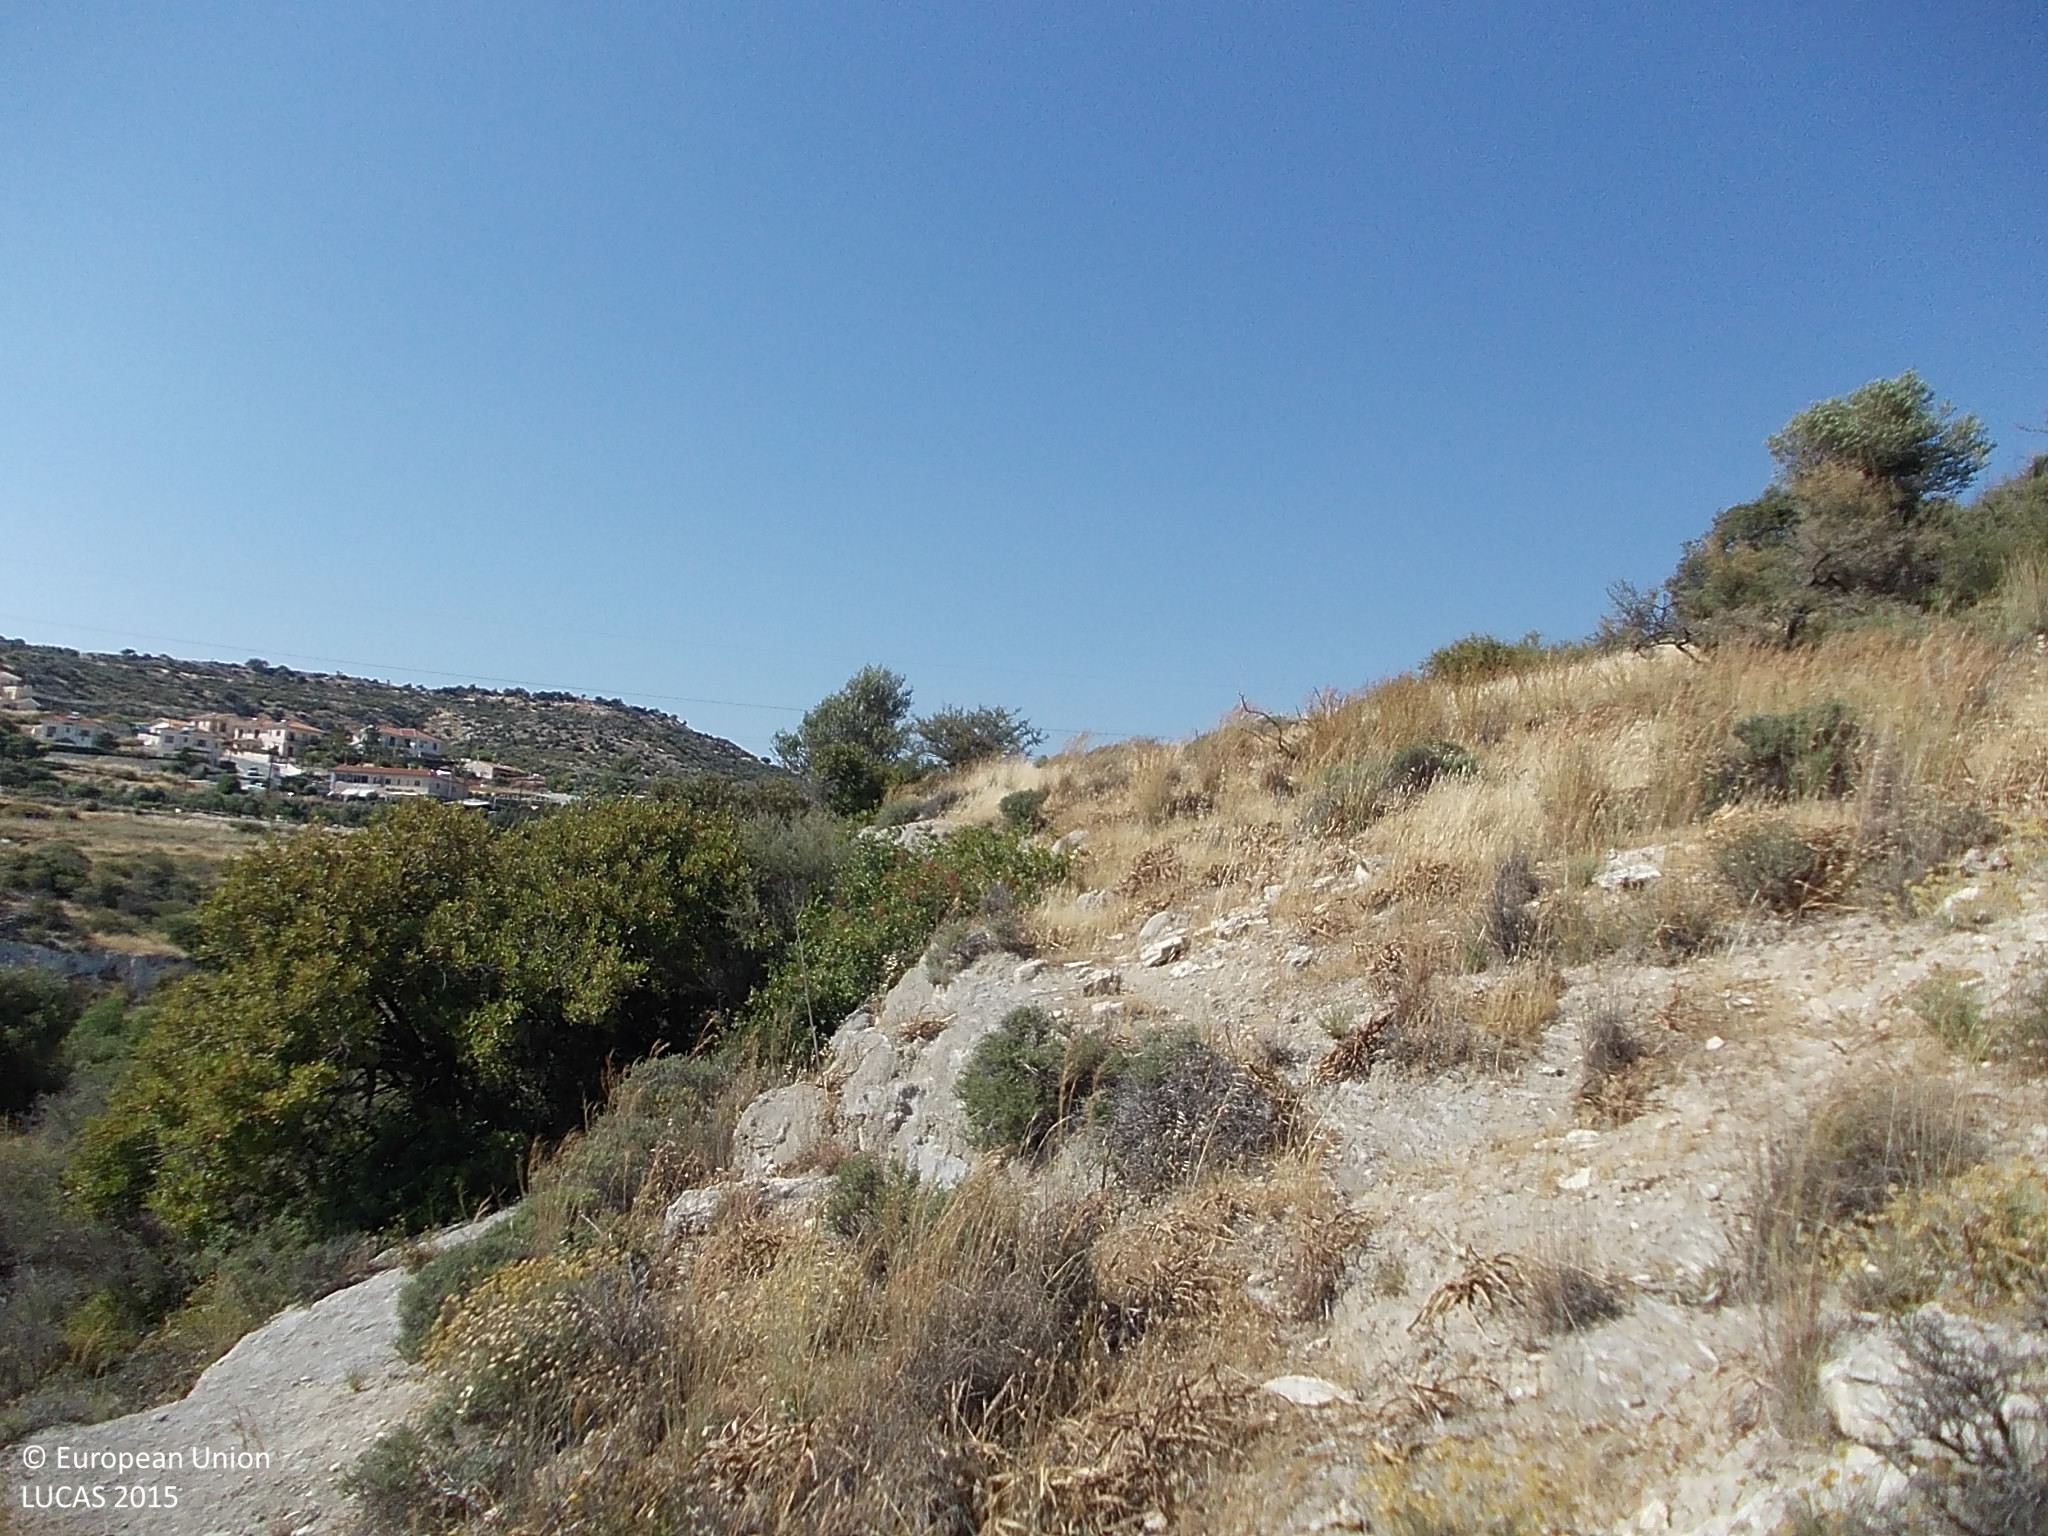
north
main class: Shrubland
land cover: Shrubland without tree cover
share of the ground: 25 - 50 %
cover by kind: shrubs 40 %, herbaceous plants 30 %, consolidated bare surface 30 %
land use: Semi-natural and natural areas not in use
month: May
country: CY
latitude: 34.6797
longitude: 32.7122
